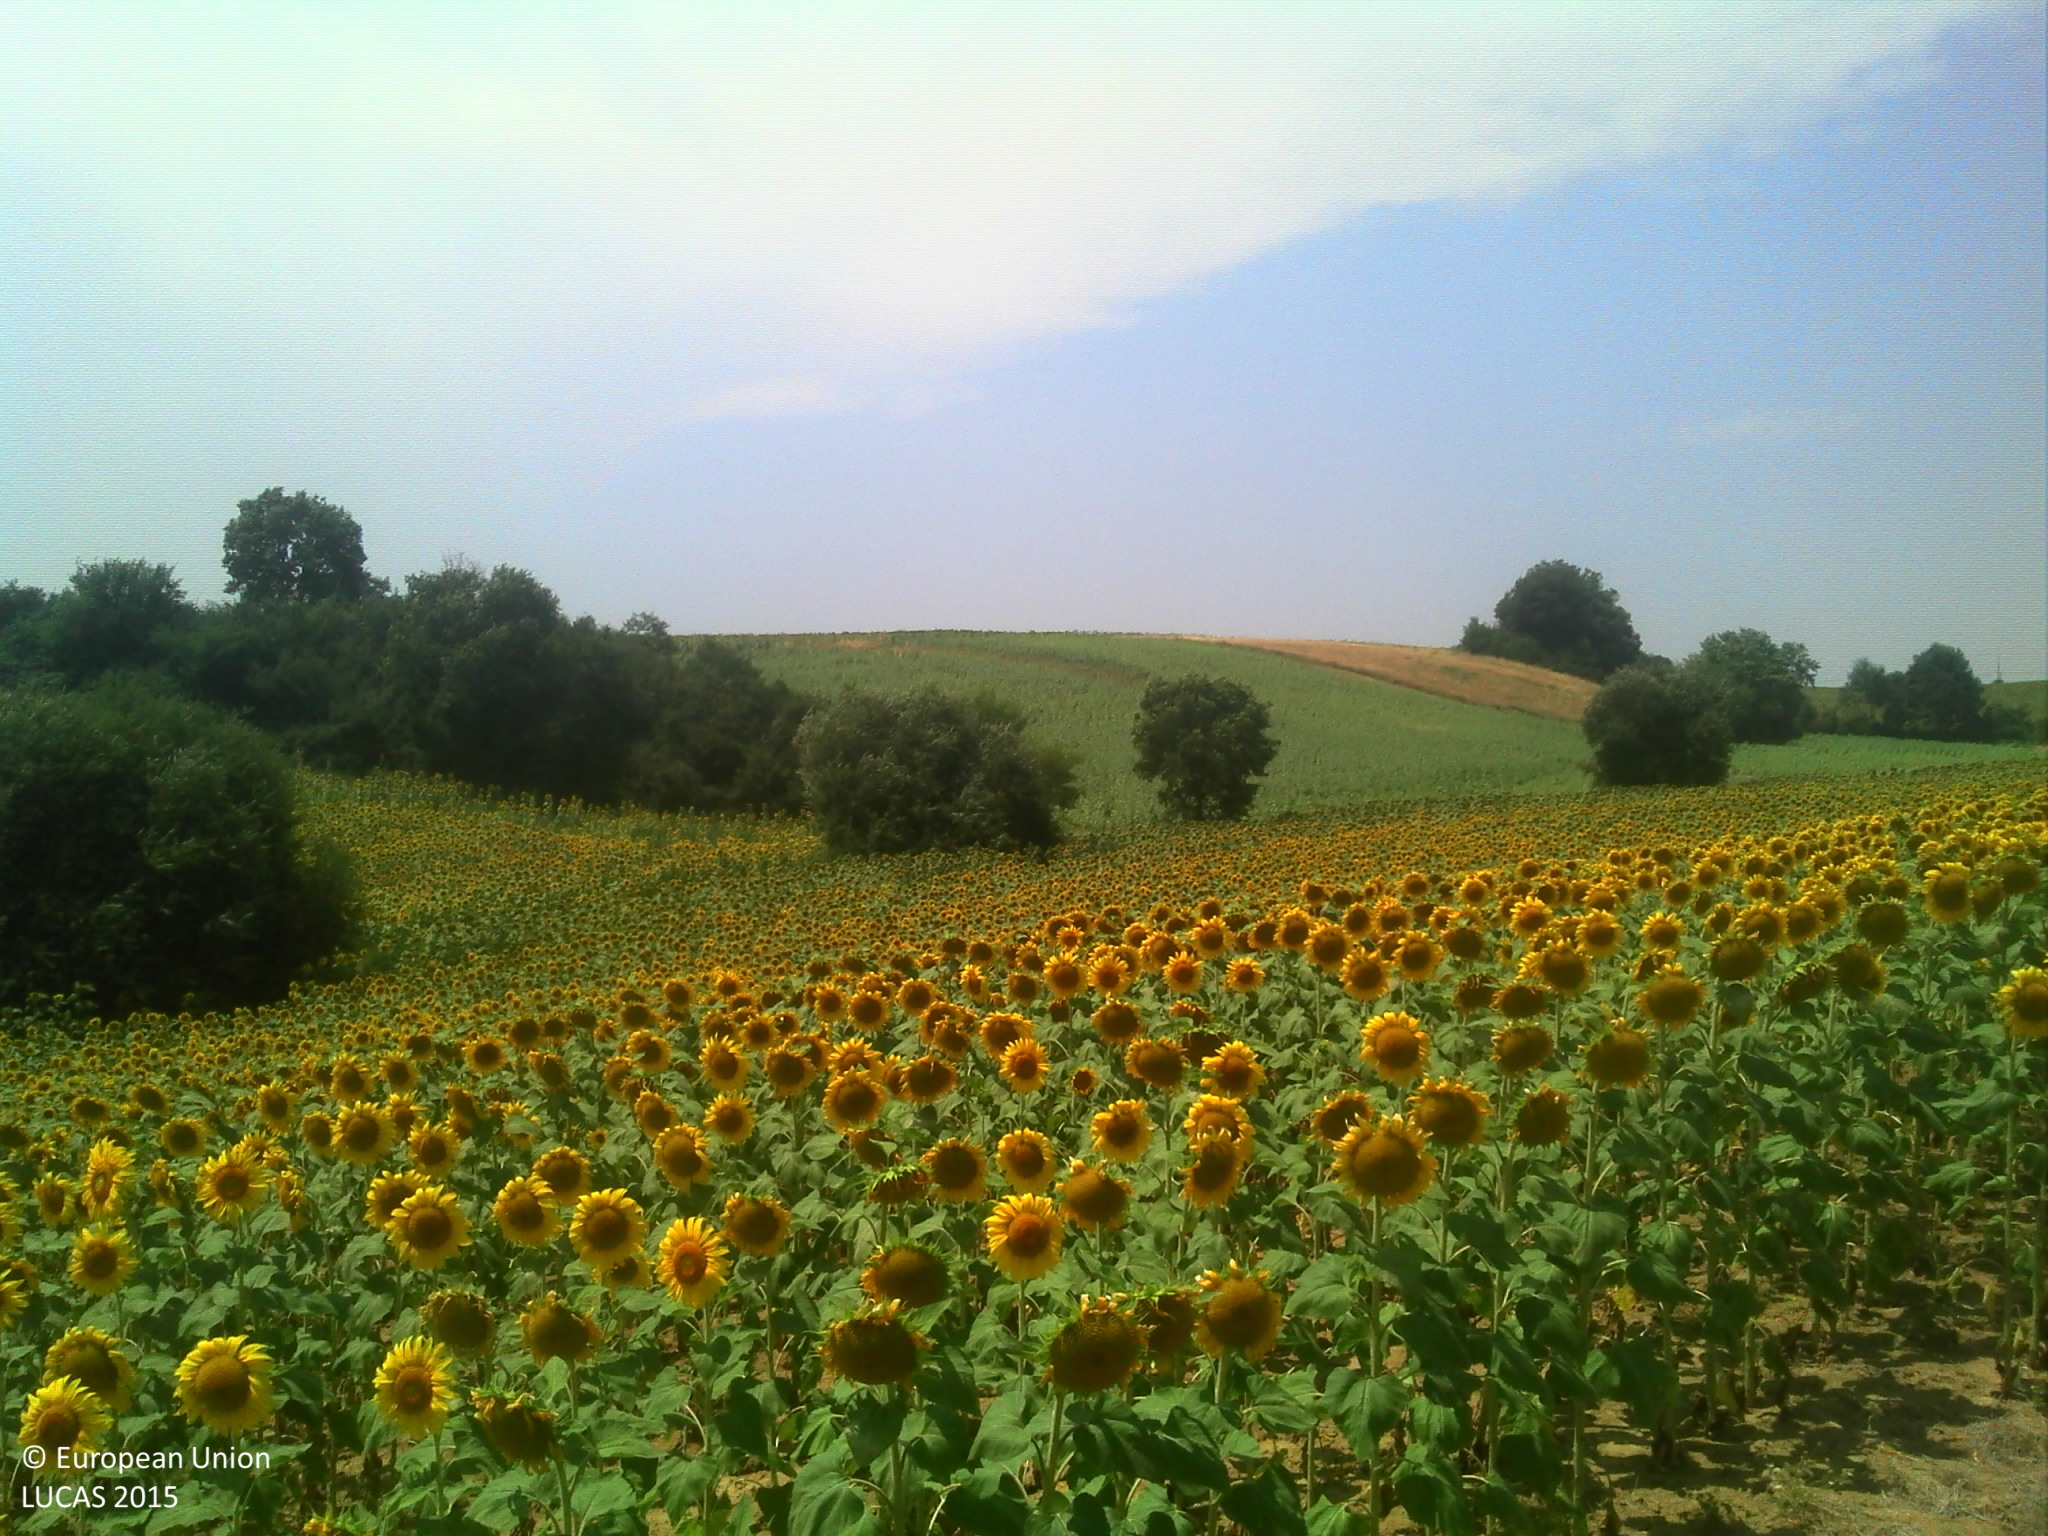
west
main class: Grassland
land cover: Grassland without tree/shrub cover
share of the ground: > 75 %
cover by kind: herbaceous plants 100 %
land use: Agriculture (excluding fallow land and kitchen gardens)
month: July
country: FR
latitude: 43.3807
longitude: 1.0283
